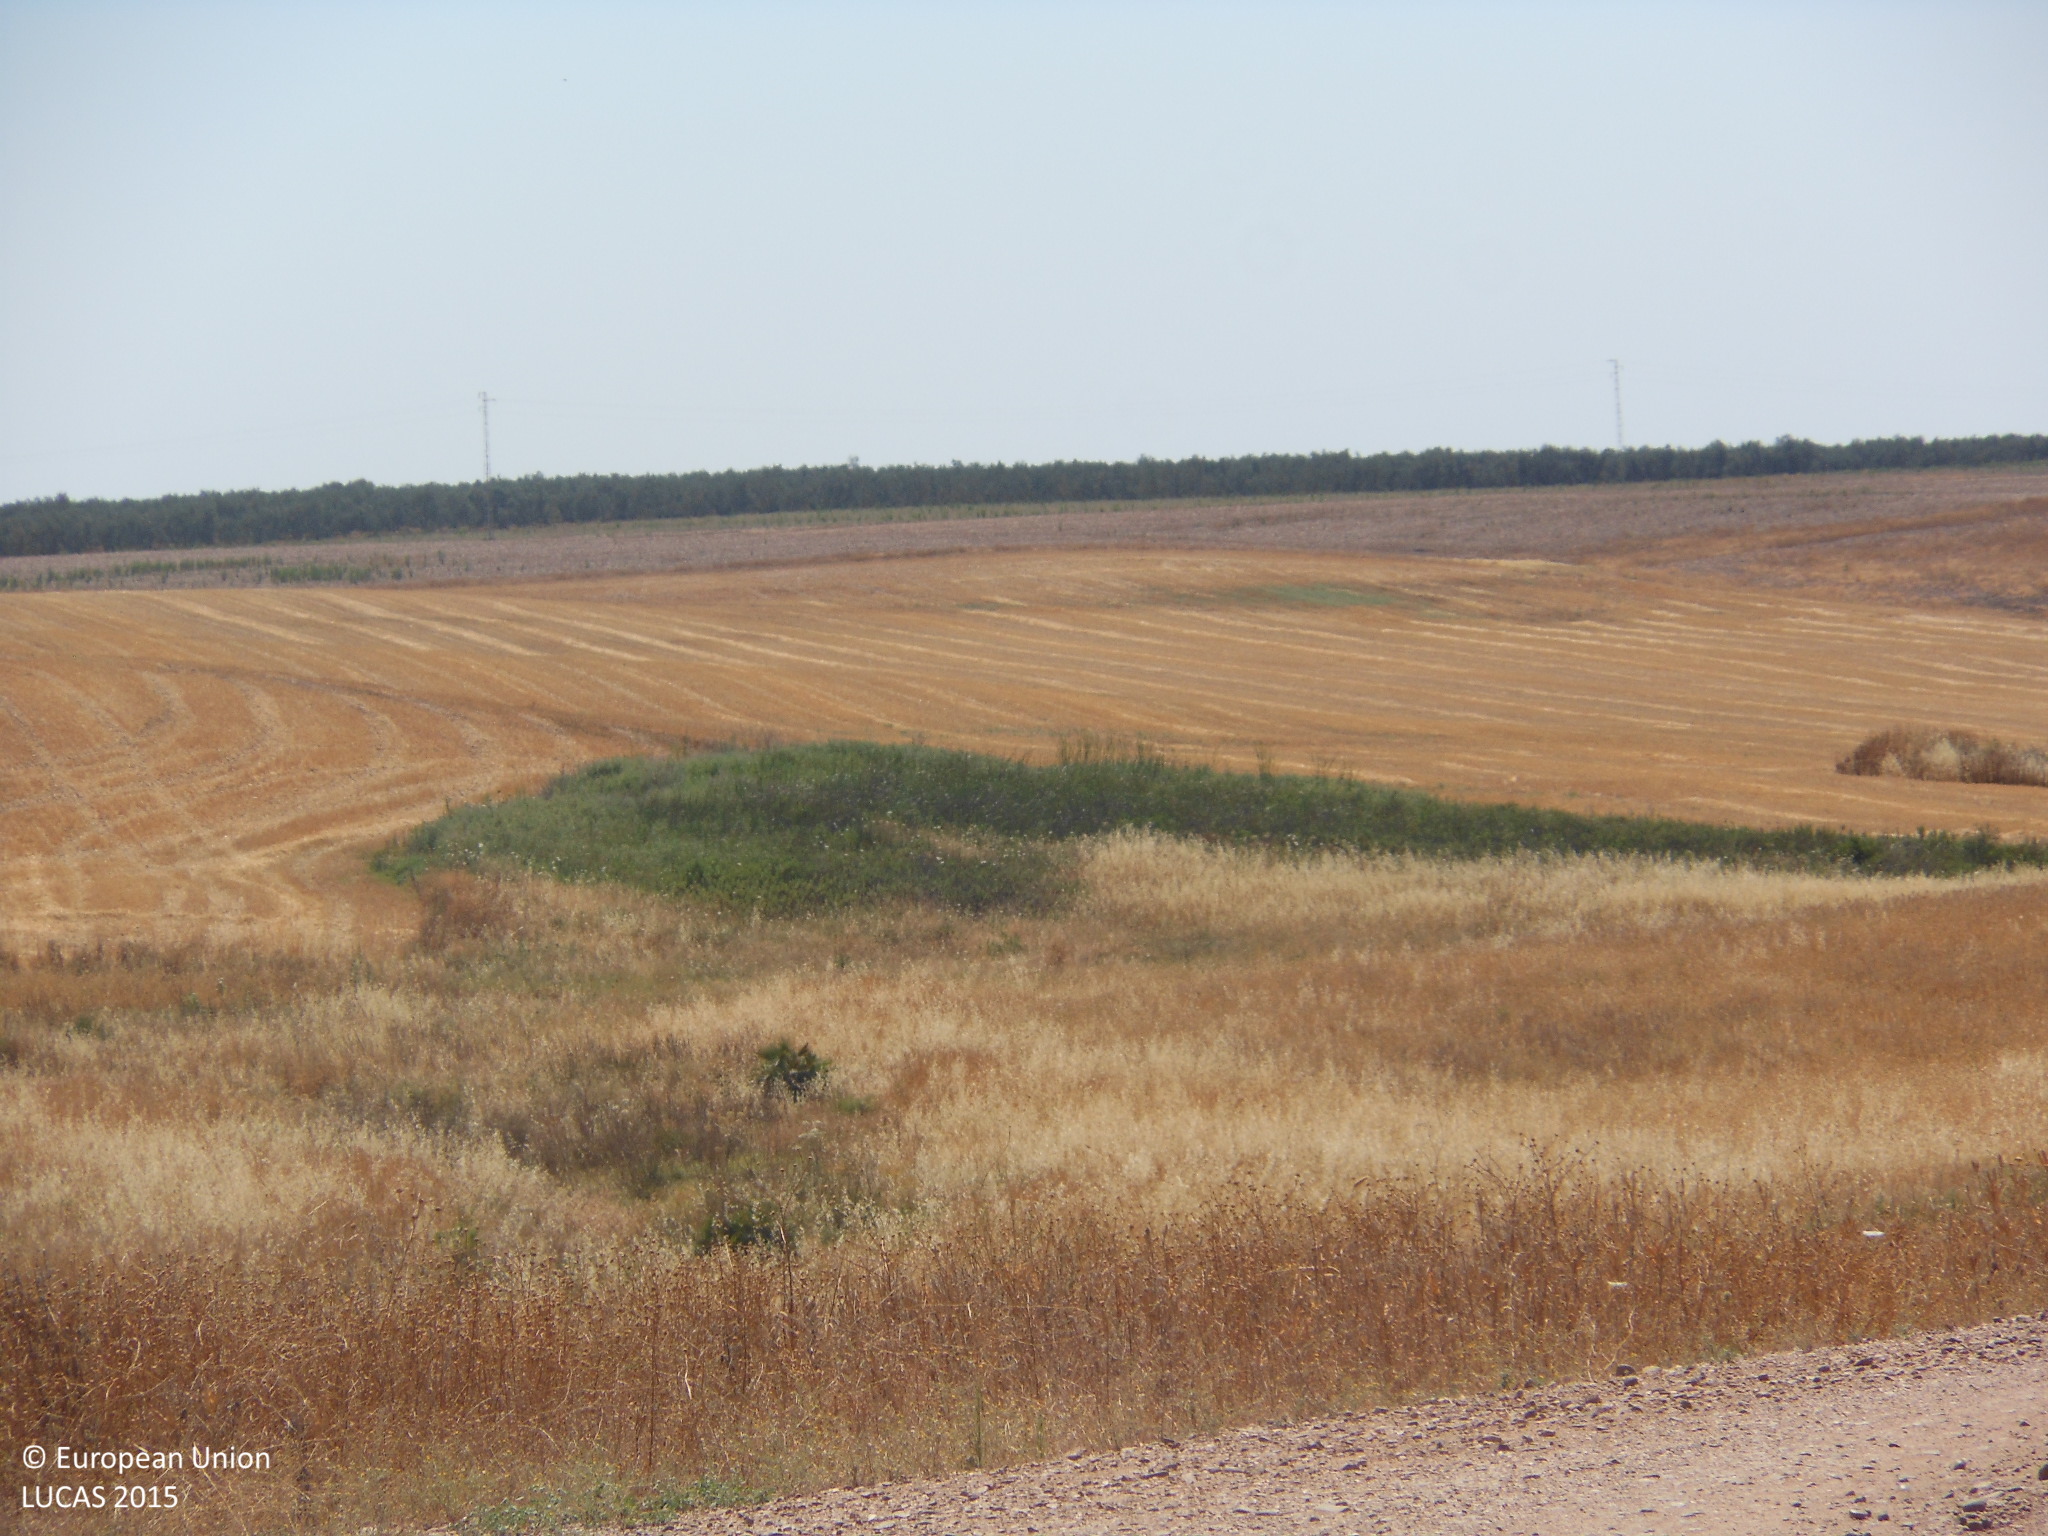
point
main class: Cropland
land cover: Arable land (only in case pi)
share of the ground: > 75 %
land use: Agriculture (excluding fallow land and kitchen gardens)
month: June
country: ES
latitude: 37.5348
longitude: -5.5115
